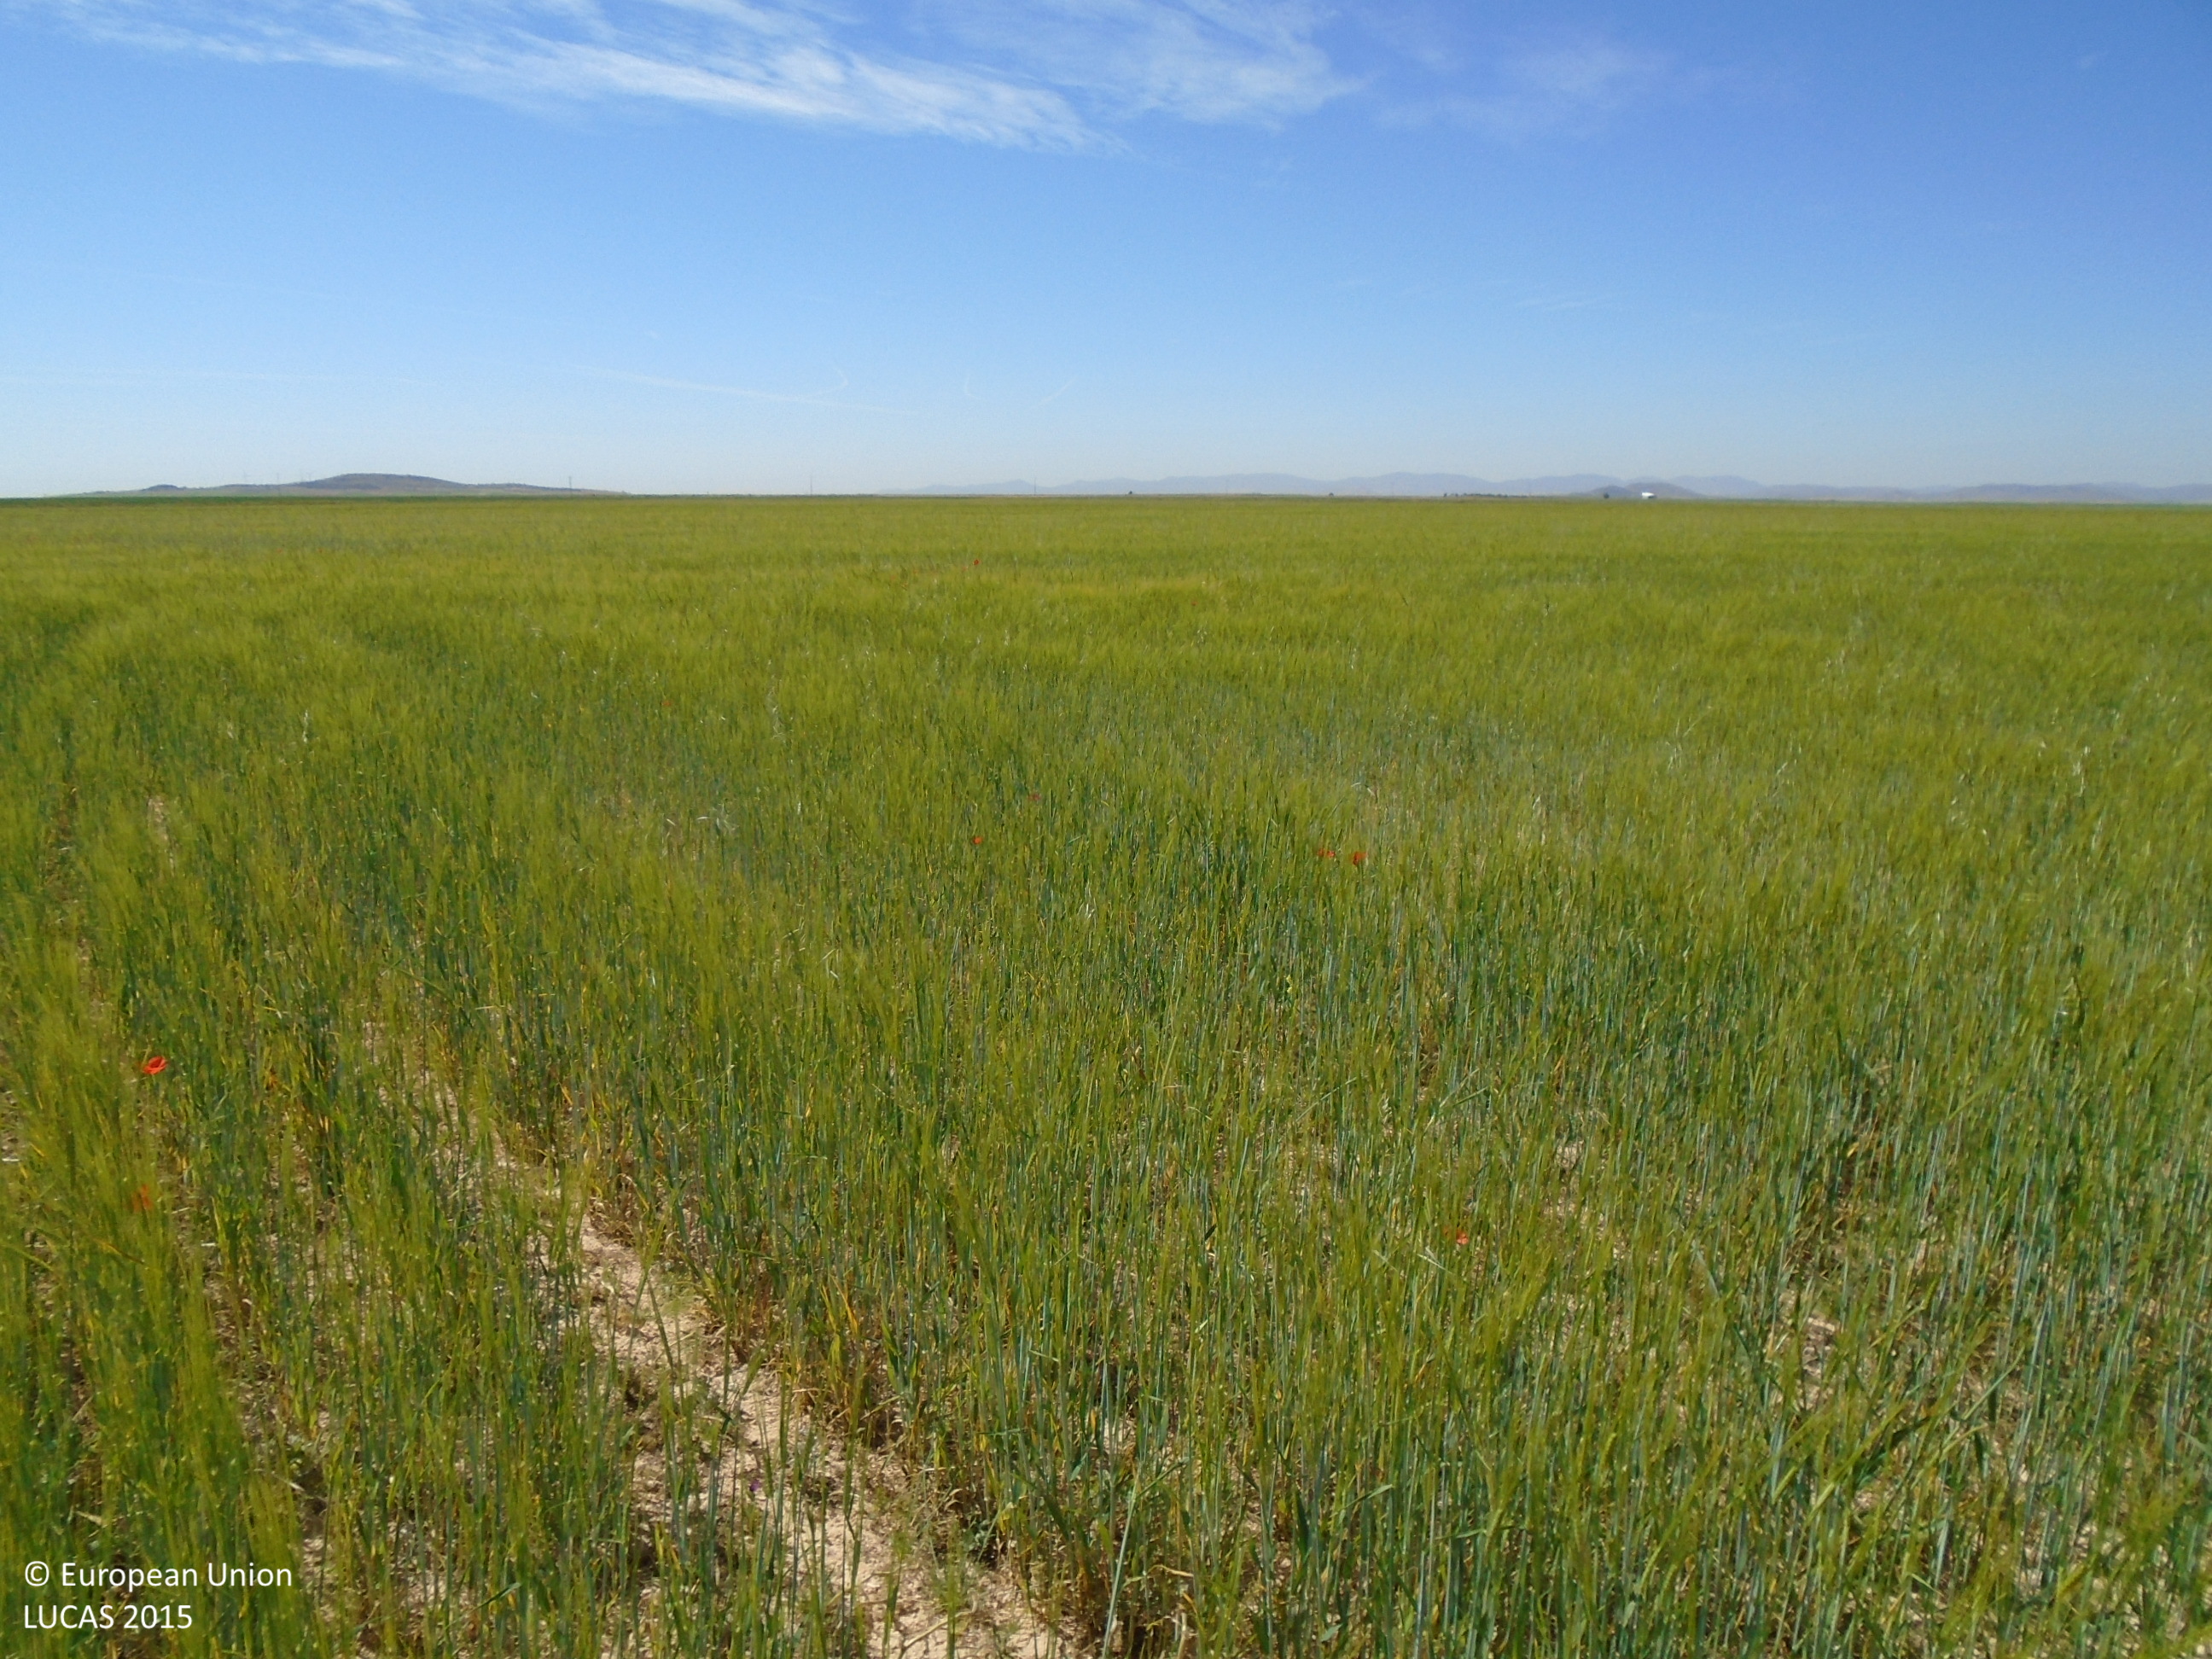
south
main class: Cropland
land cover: Barley
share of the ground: > 75 %
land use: Agriculture (excluding fallow land and kitchen gardens)
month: May
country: ES
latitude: 39.6304
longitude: -3.5752
